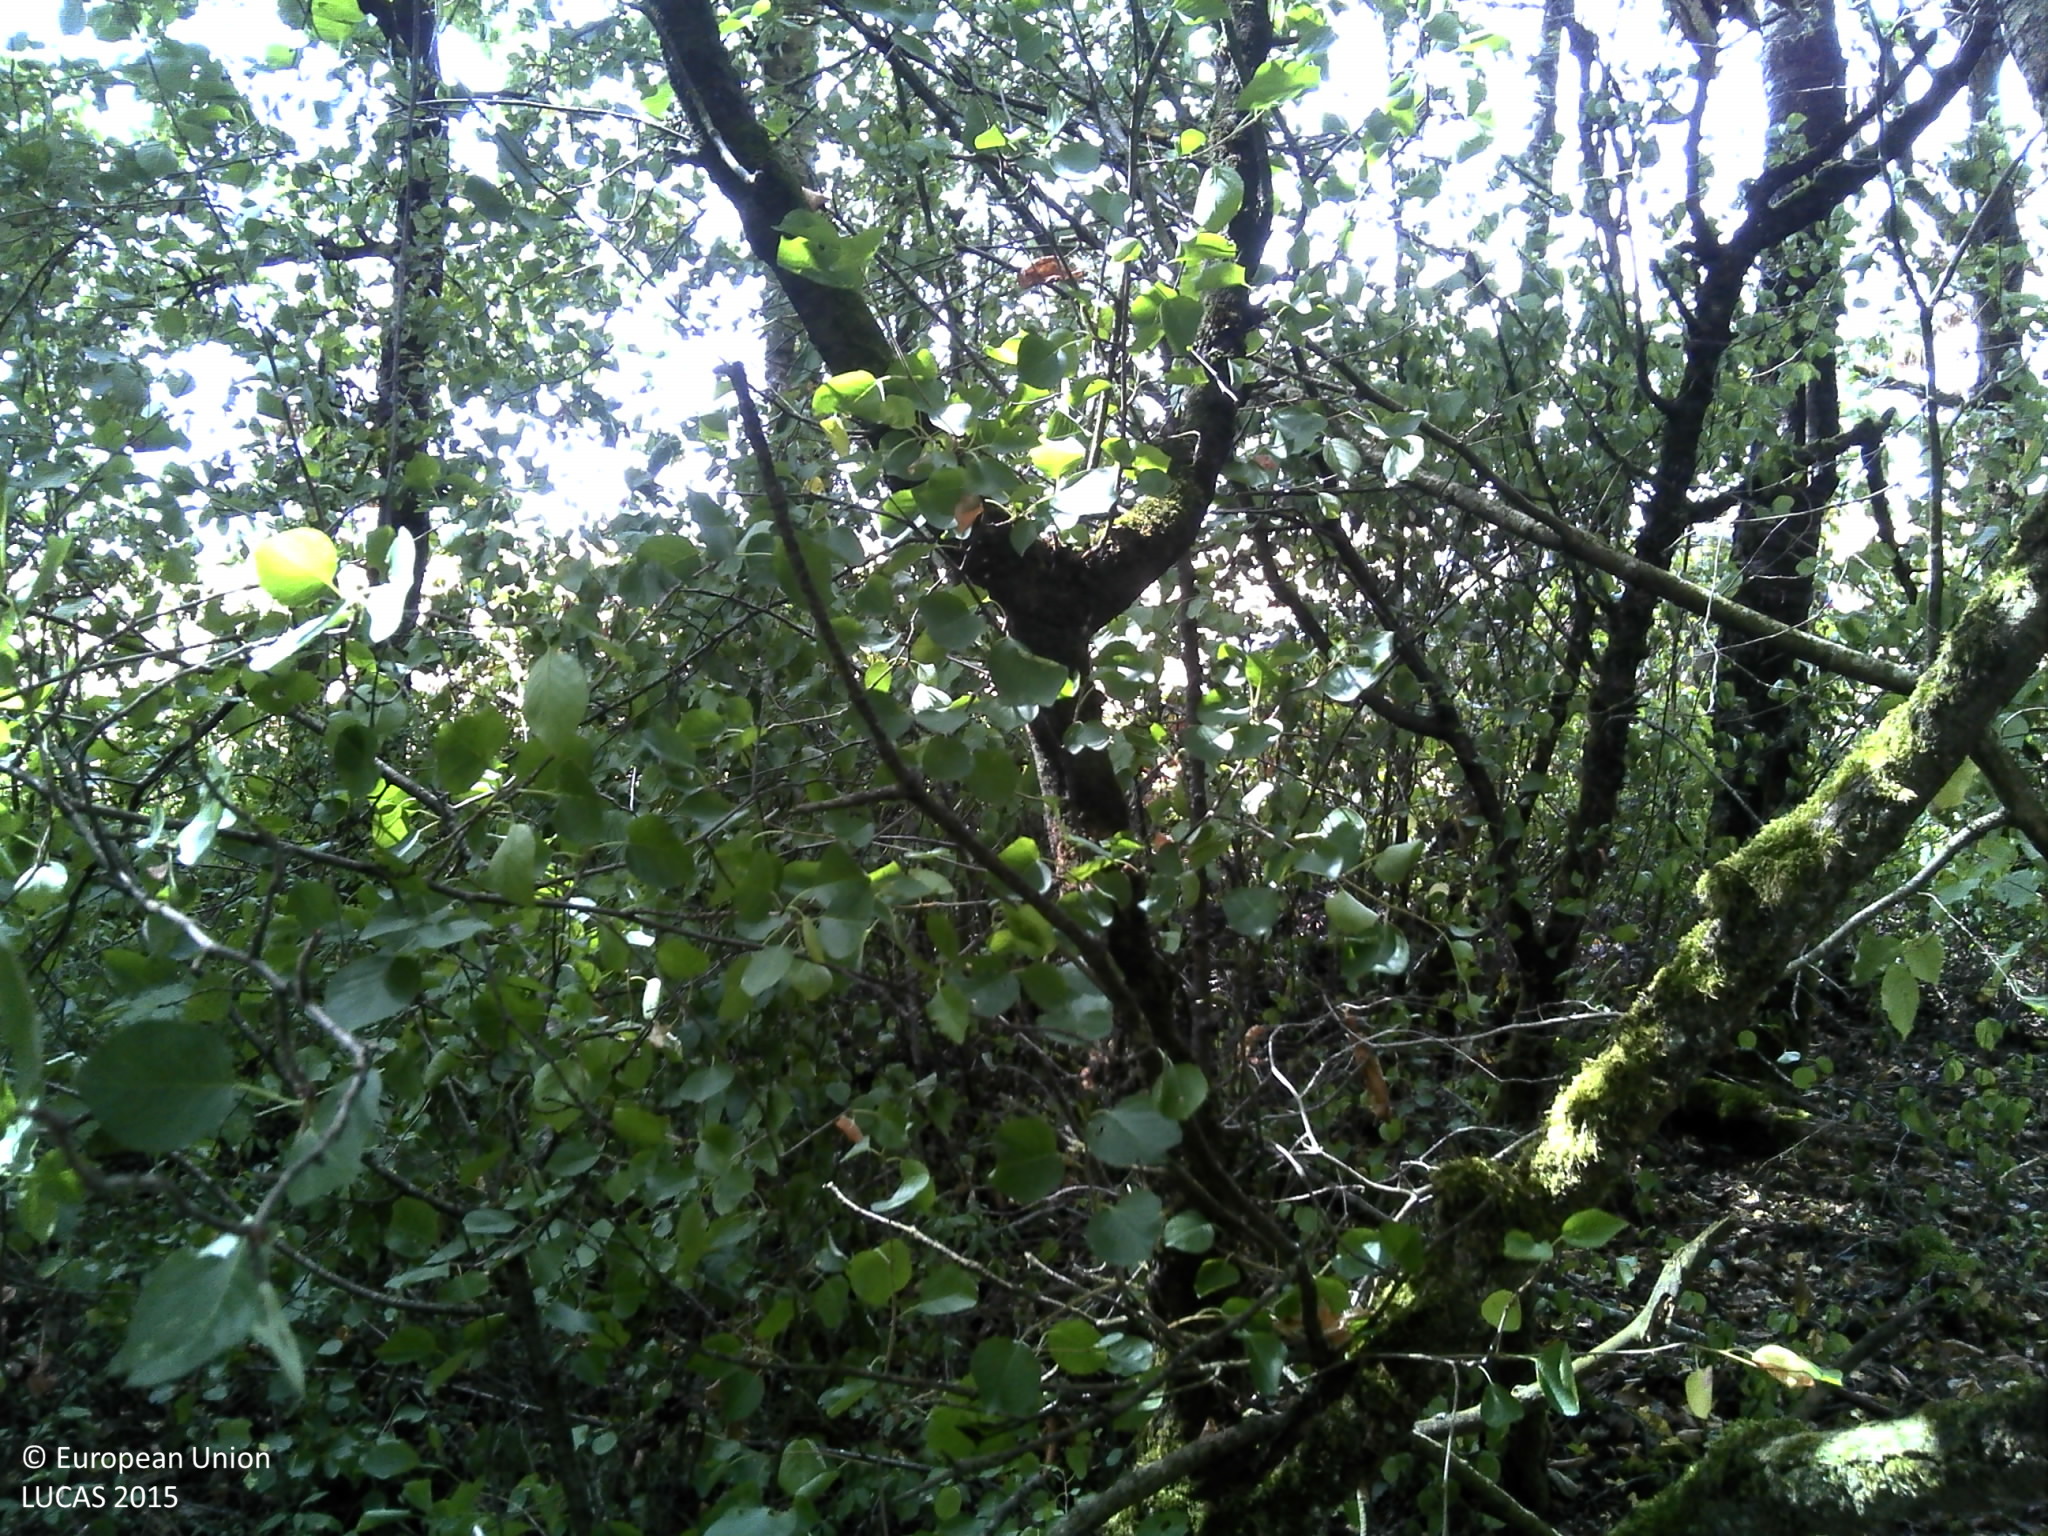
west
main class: Woodland
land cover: Broadleaved woodland
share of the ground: > 75 %
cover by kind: broadleaved forest trees 85 %, coniferous forest trees 10 %, herbaceous plants 5 %
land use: Forestry
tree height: > 5 m
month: August
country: FR
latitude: 48.8659
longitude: 4.5850
